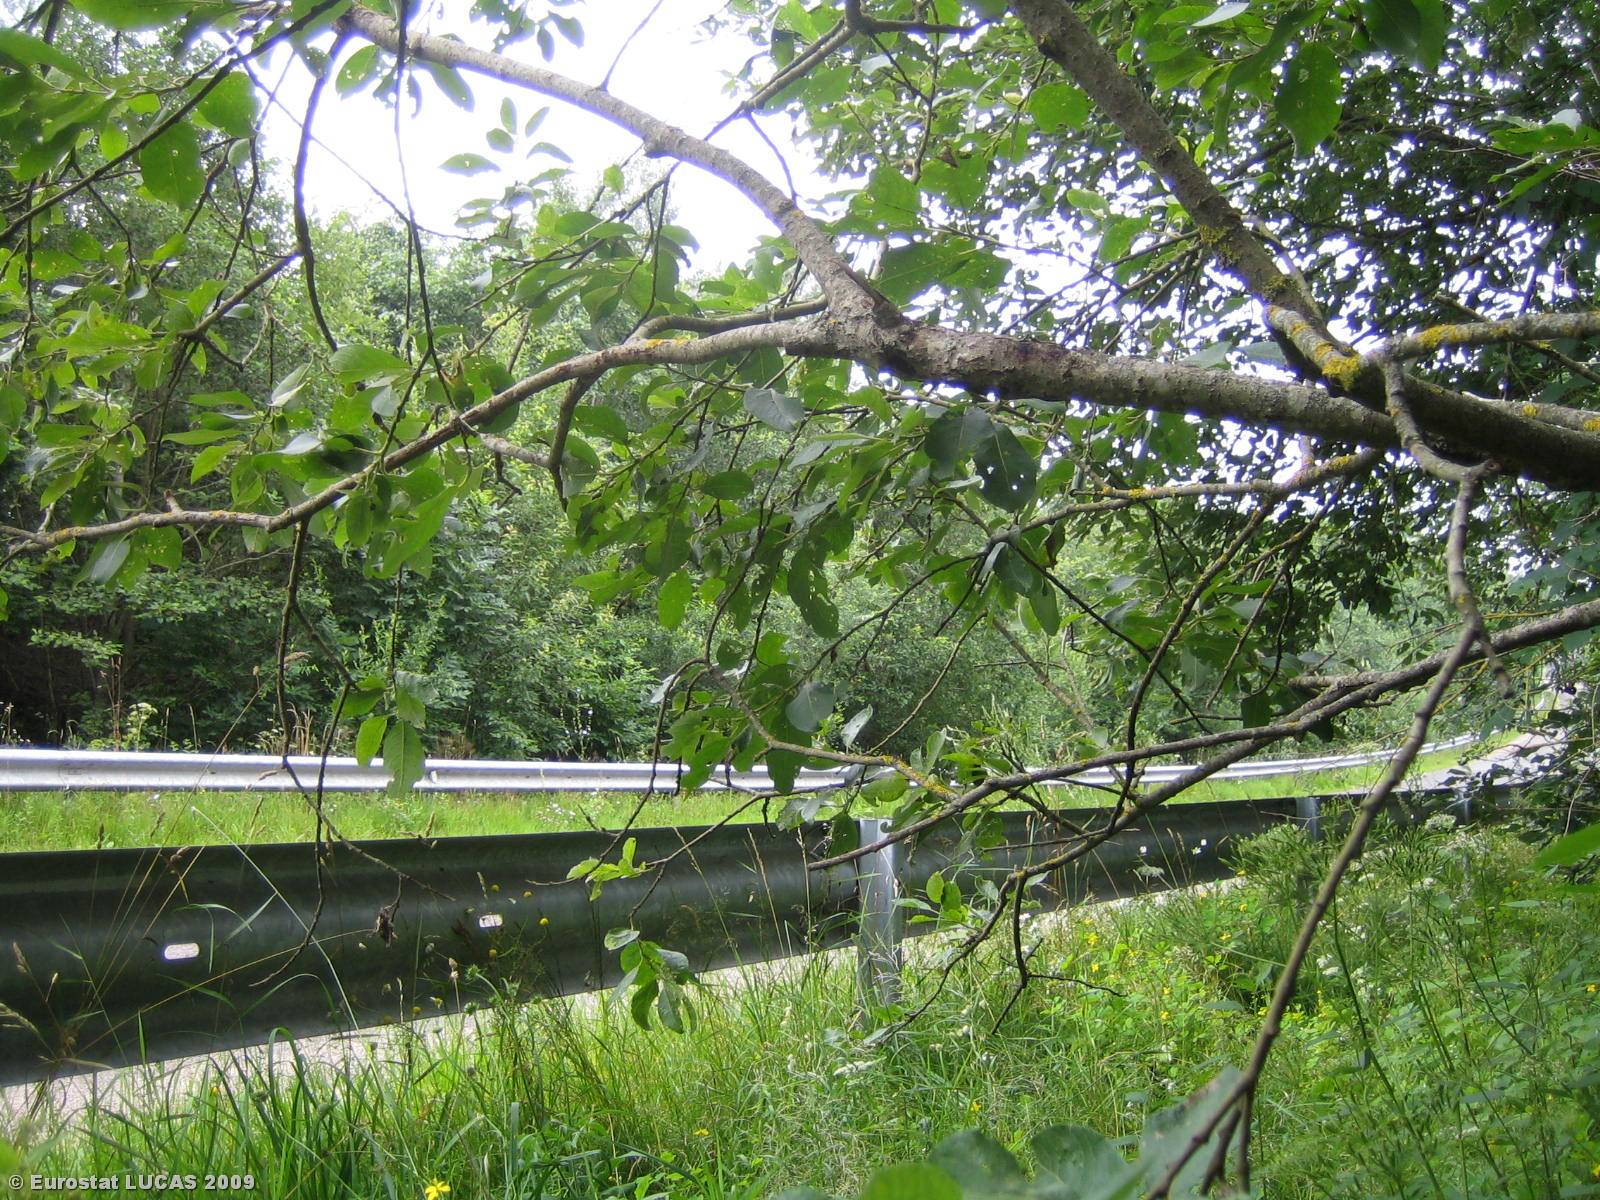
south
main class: Woodland
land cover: Broadleaved woodland
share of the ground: > 75 %
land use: Forestry
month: July
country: LT
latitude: 55.4562
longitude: 25.5110
